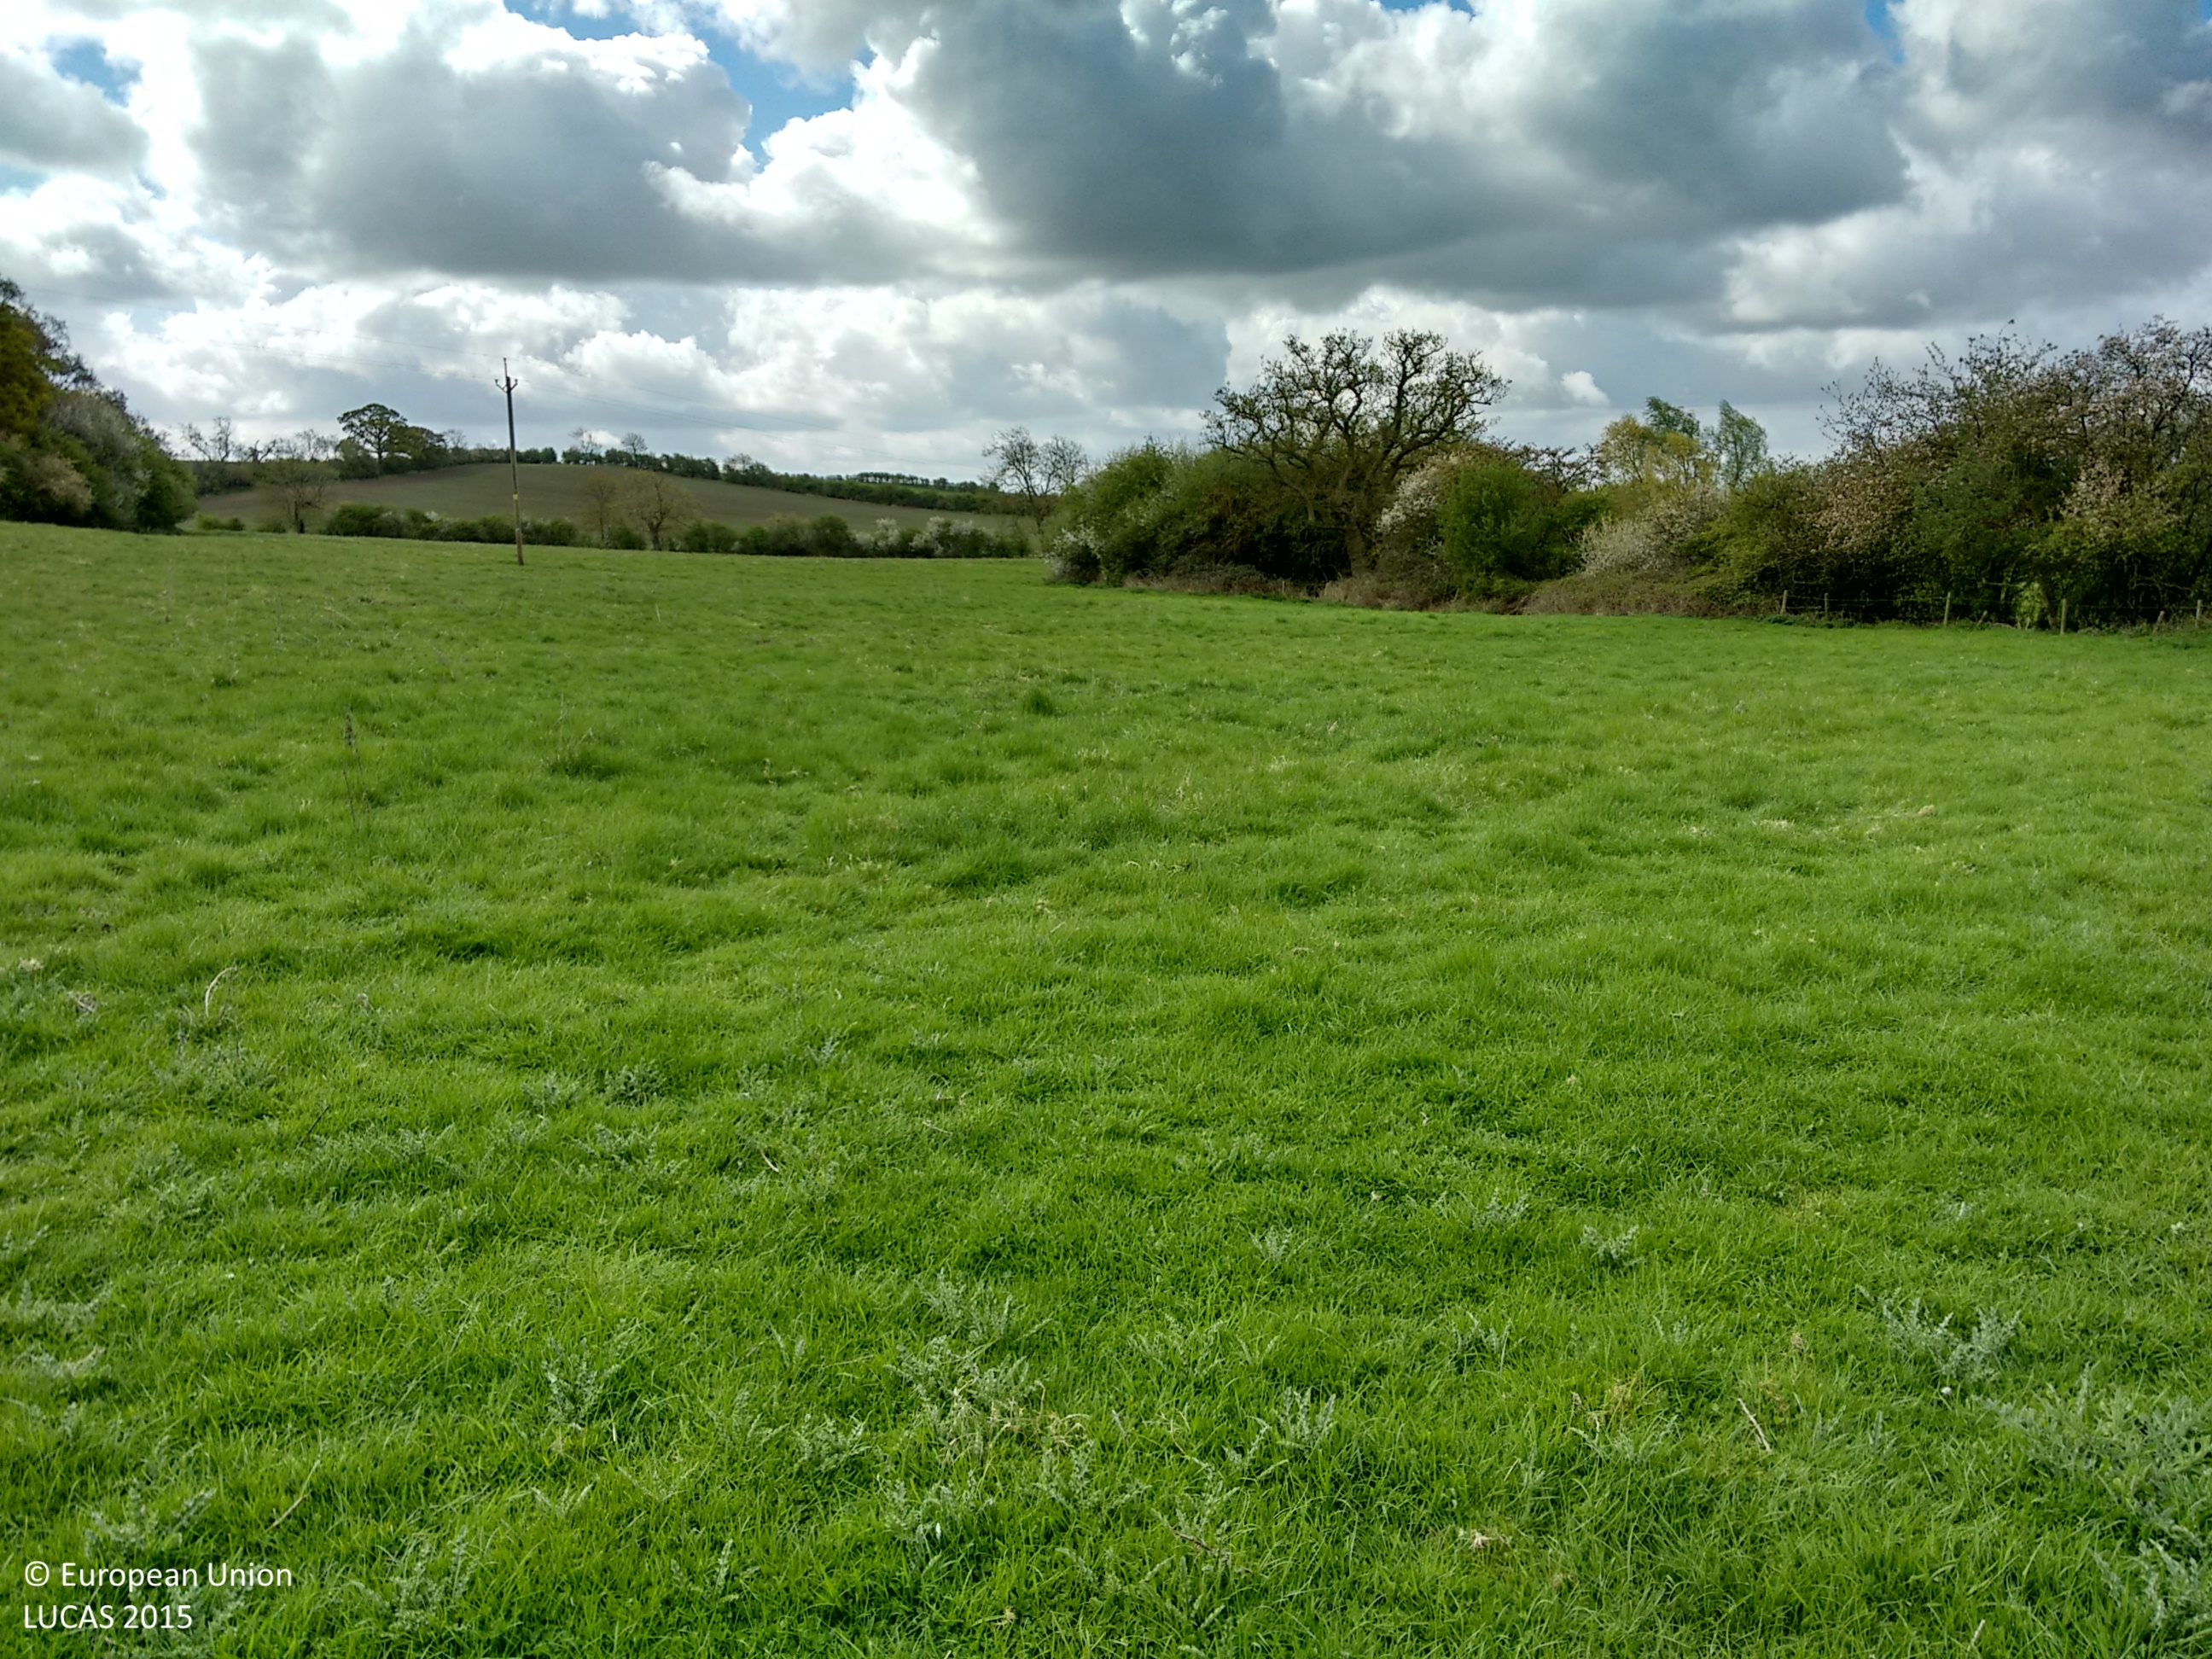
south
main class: Cropland
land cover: Nuts trees
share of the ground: > 75 %
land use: Agriculture (excluding fallow land and kitchen gardens)
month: April
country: GB
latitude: 51.8674
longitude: -0.7740
